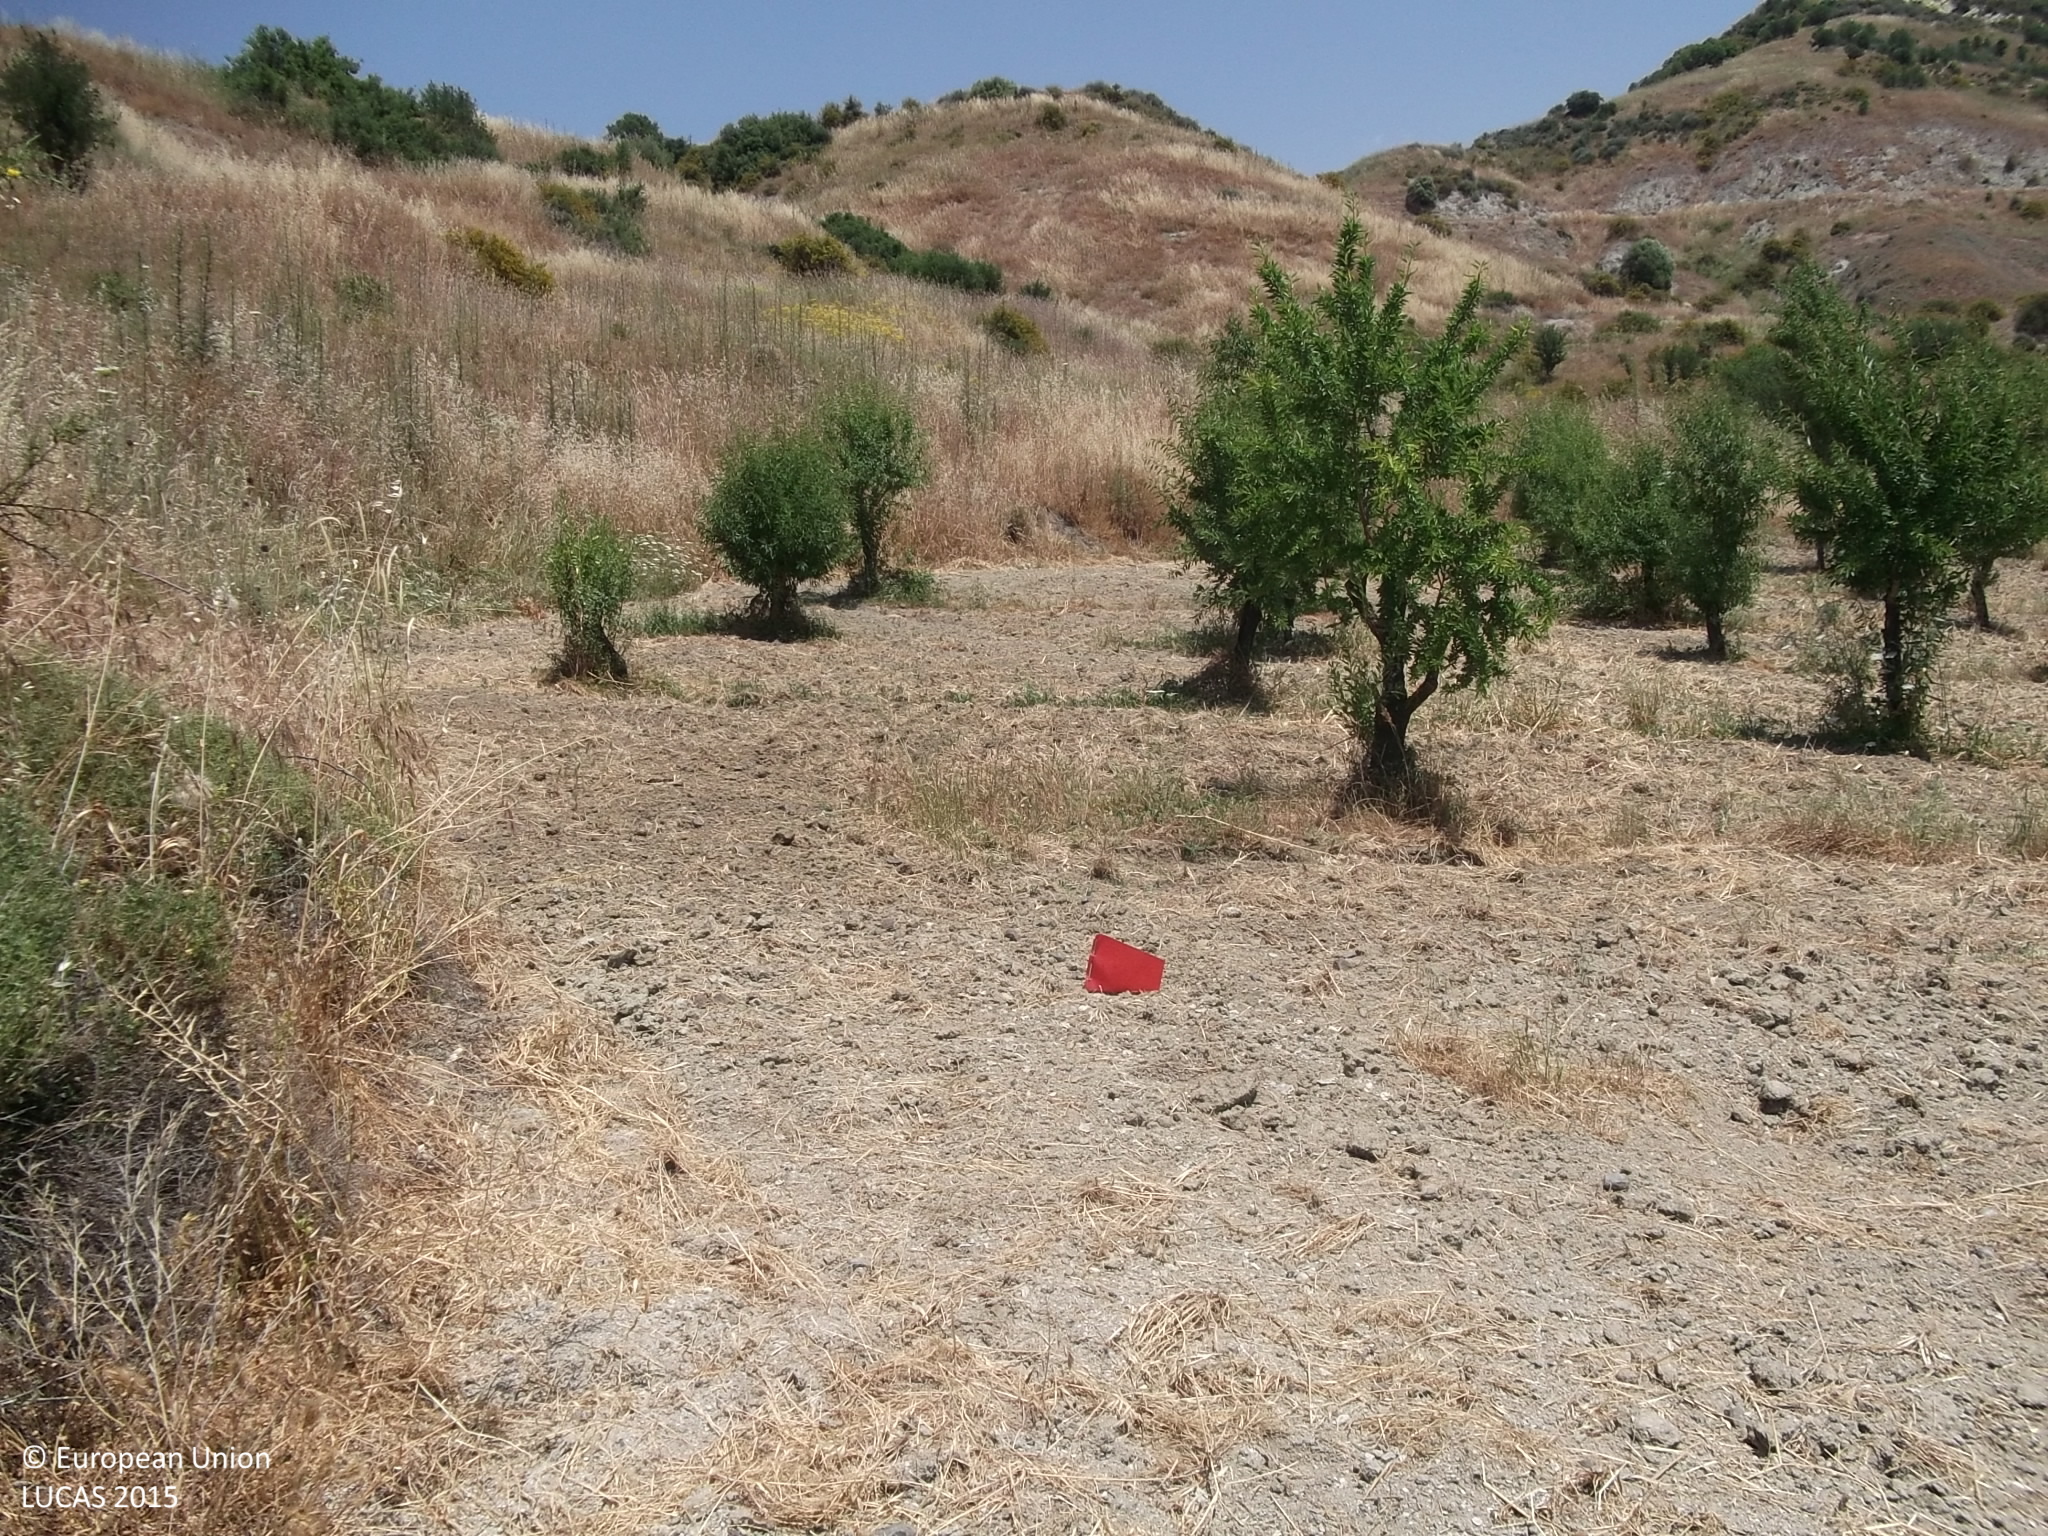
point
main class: Cropland
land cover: Other fruit trees and berries
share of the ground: 25 - 50 %
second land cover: Other bare soil
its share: > 75 %
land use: Agriculture (excluding fallow land and kitchen gardens)
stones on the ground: 10 - 25 %
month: May
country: CY
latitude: 34.9182
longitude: 32.5834
